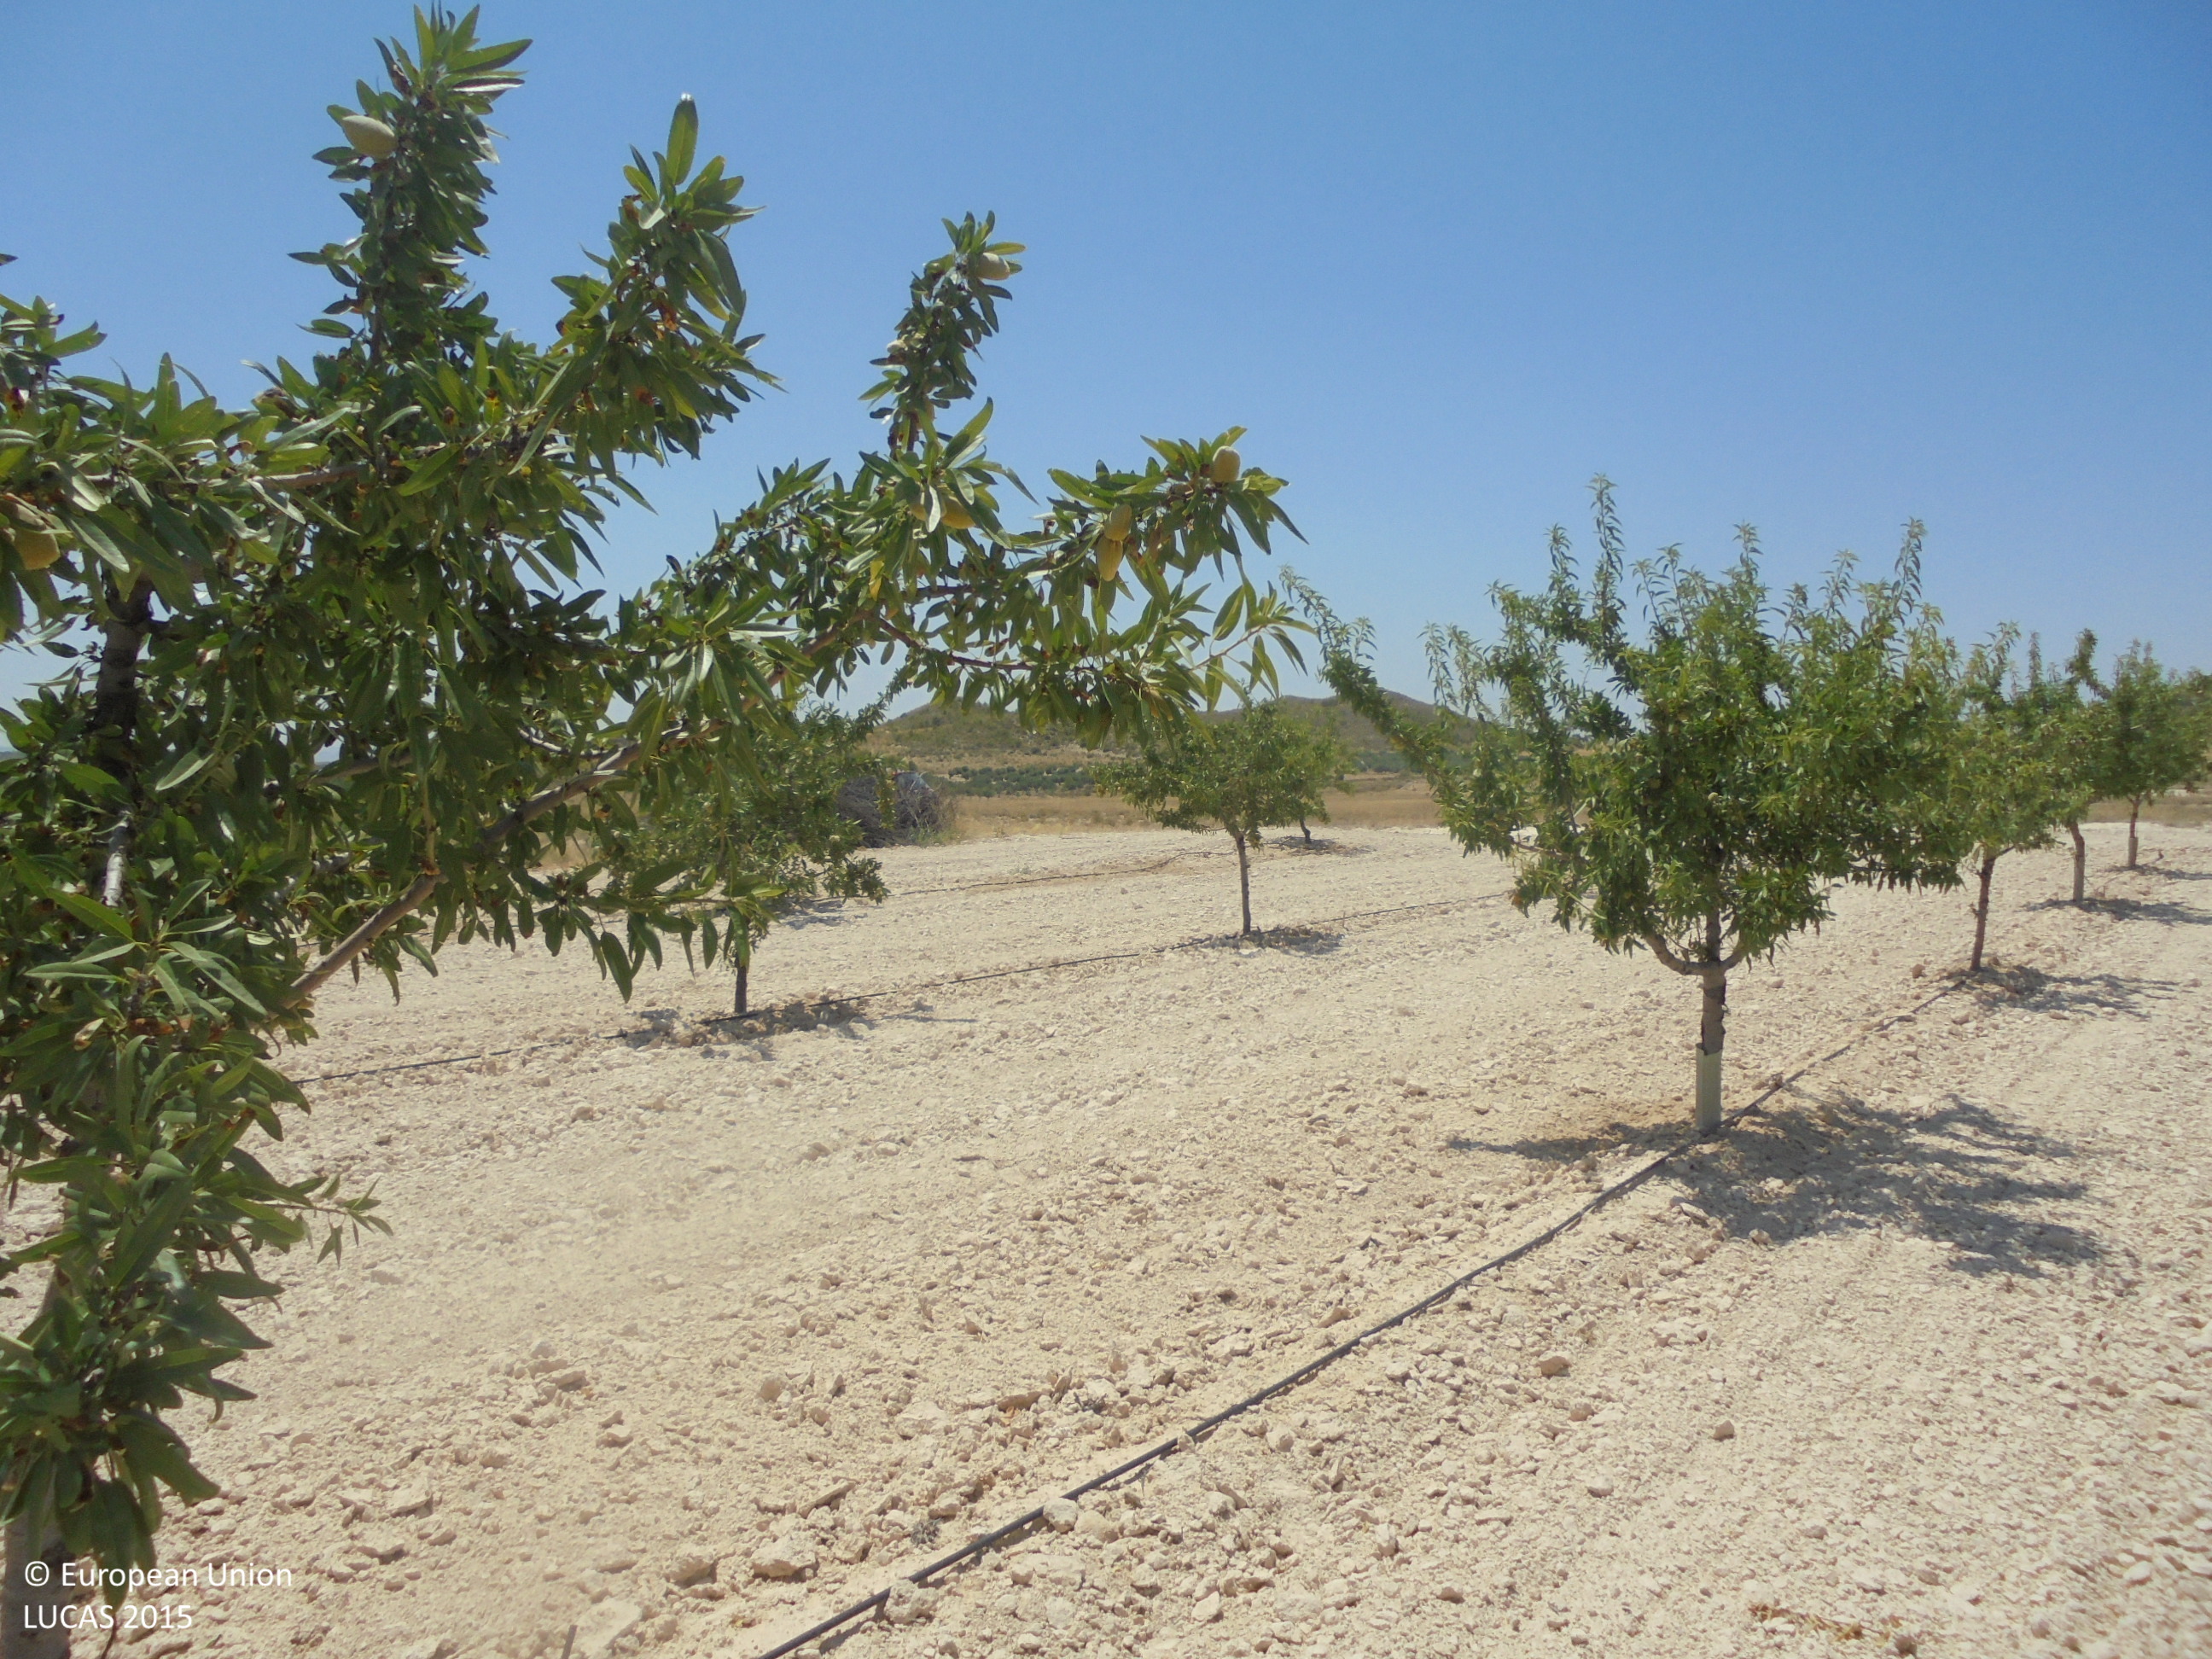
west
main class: Cropland
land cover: Nuts trees
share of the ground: 10 - 25 %
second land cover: Other bare soil
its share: > 75 %
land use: Agriculture (excluding fallow land and kitchen gardens)
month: July
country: ES
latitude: 38.5982
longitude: -1.5328
